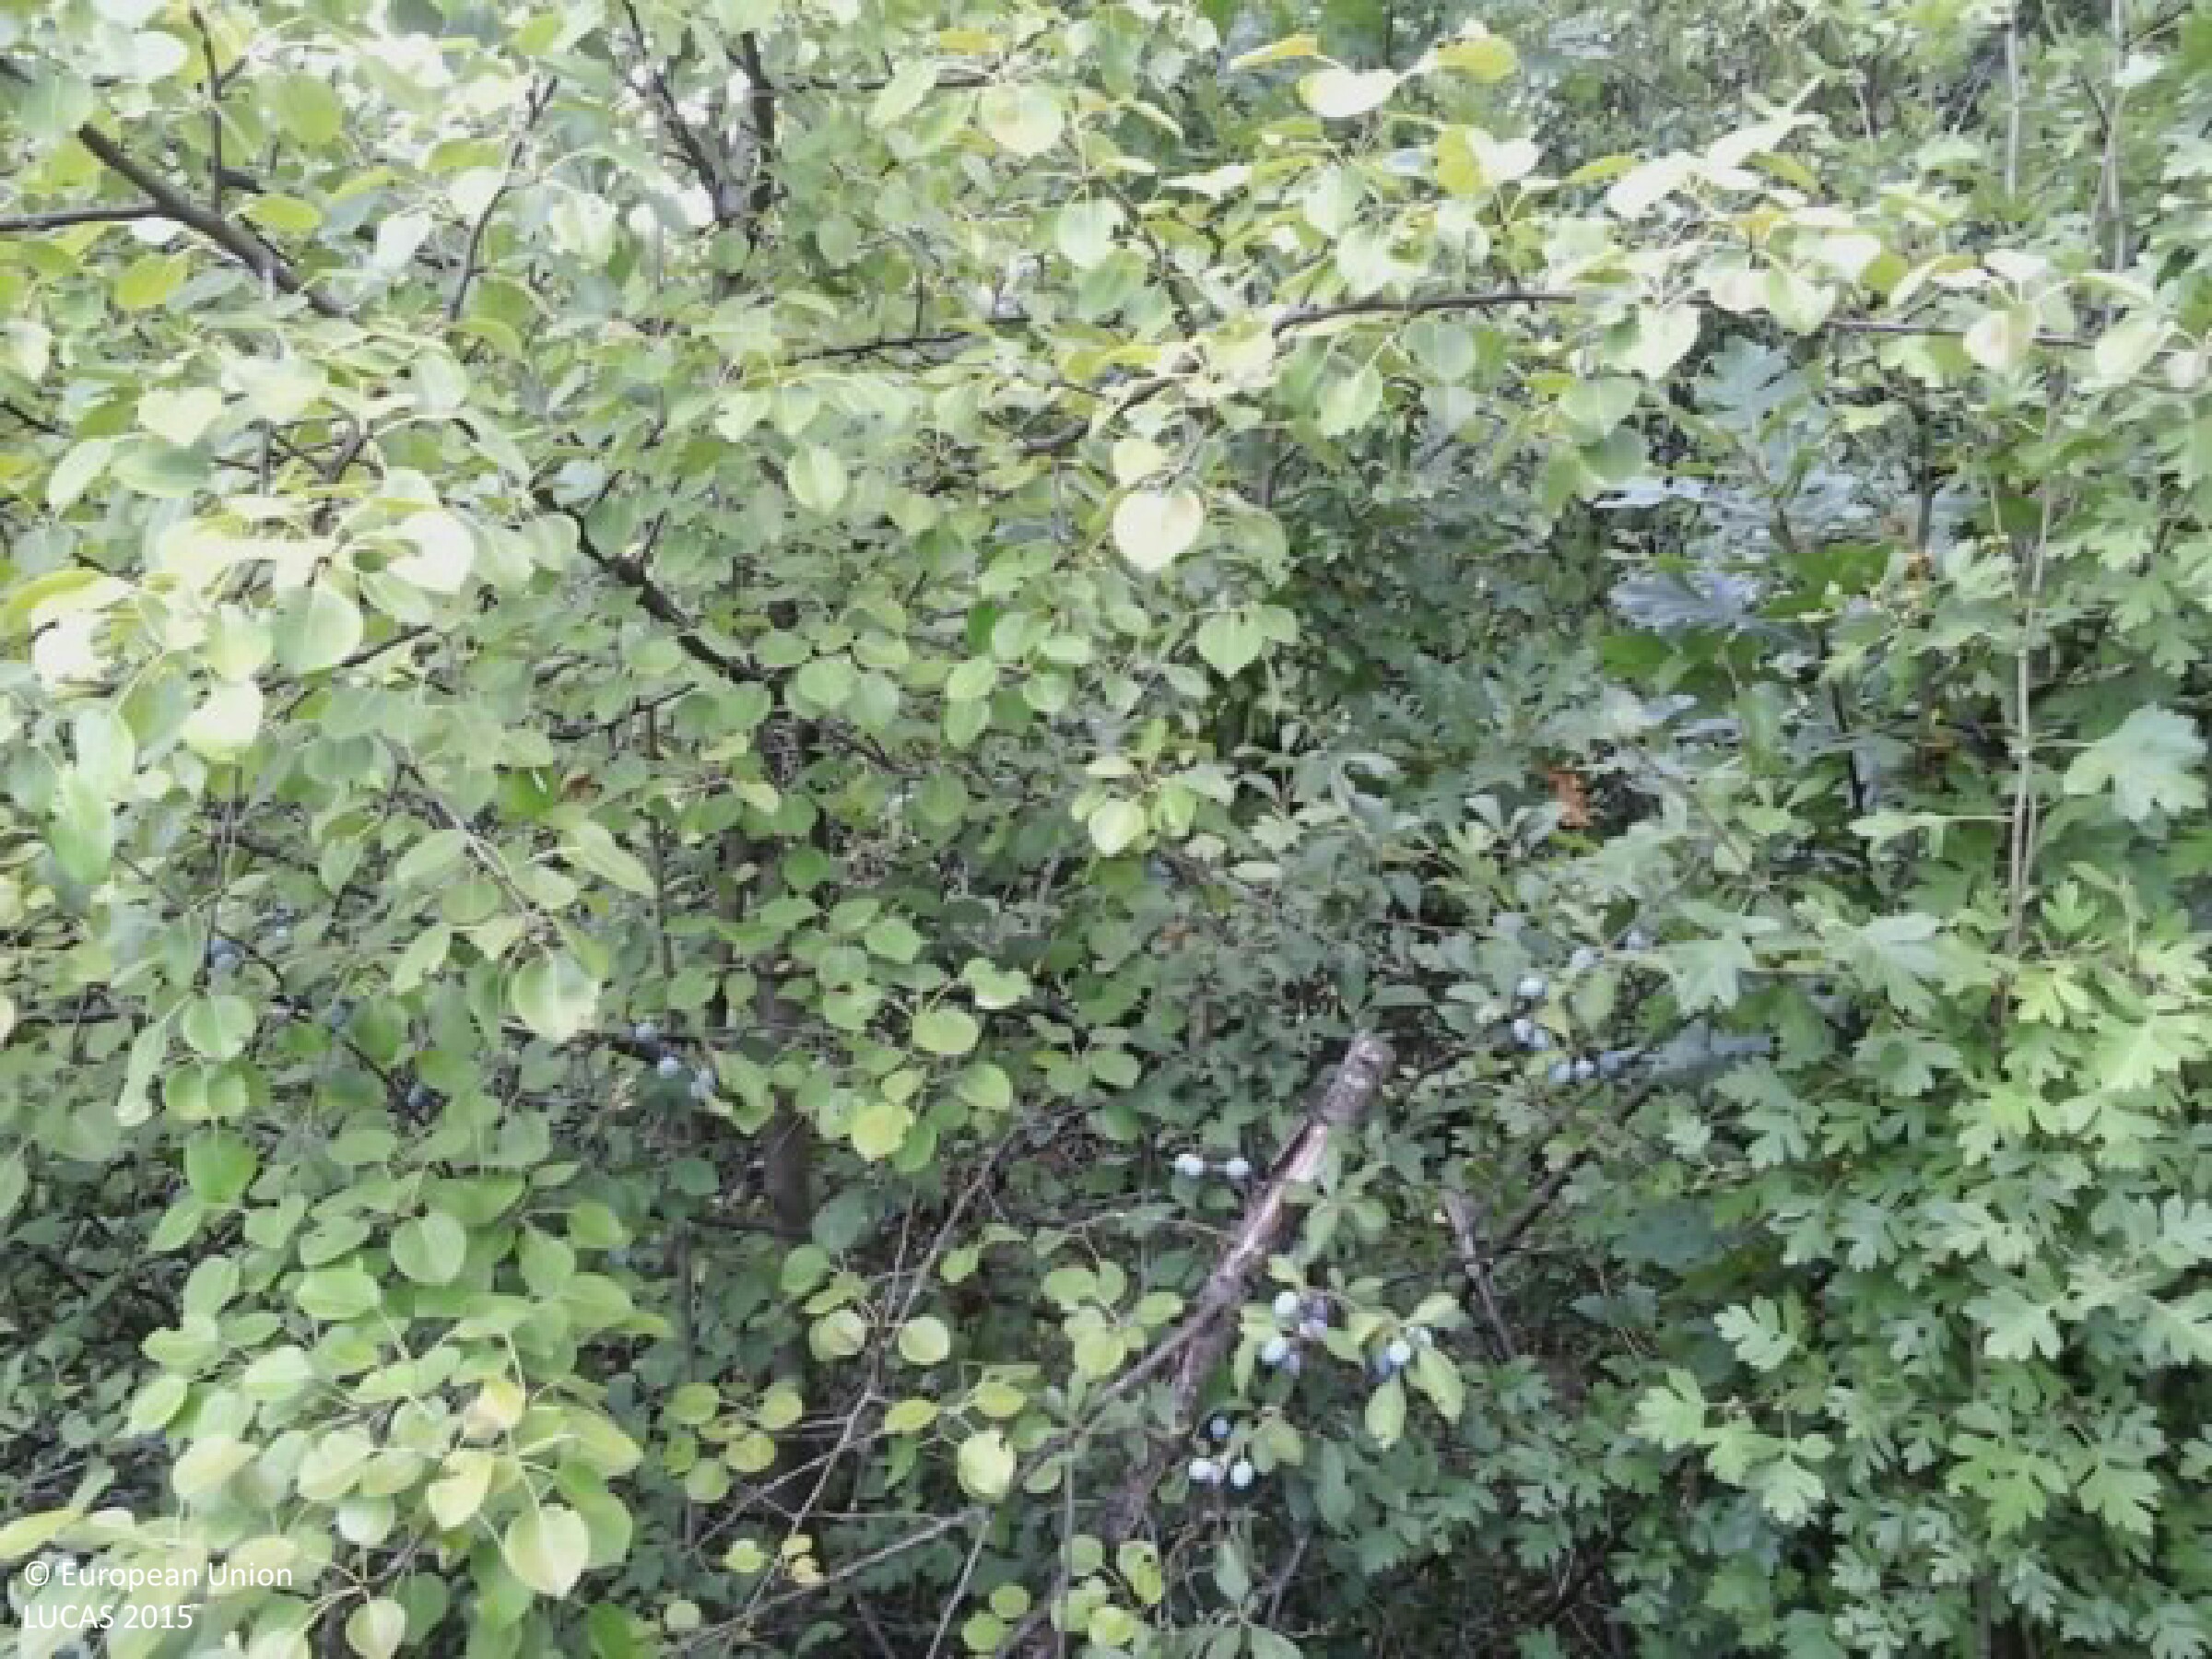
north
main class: Shrubland
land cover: Shrubland with sparse tree cover
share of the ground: > 75 %
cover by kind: shrubs 95 %, broadleaved forest trees 5 %
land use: Semi-natural and natural areas not in use
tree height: < 5 m
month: July
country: HU
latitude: 48.3509
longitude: 20.7379
